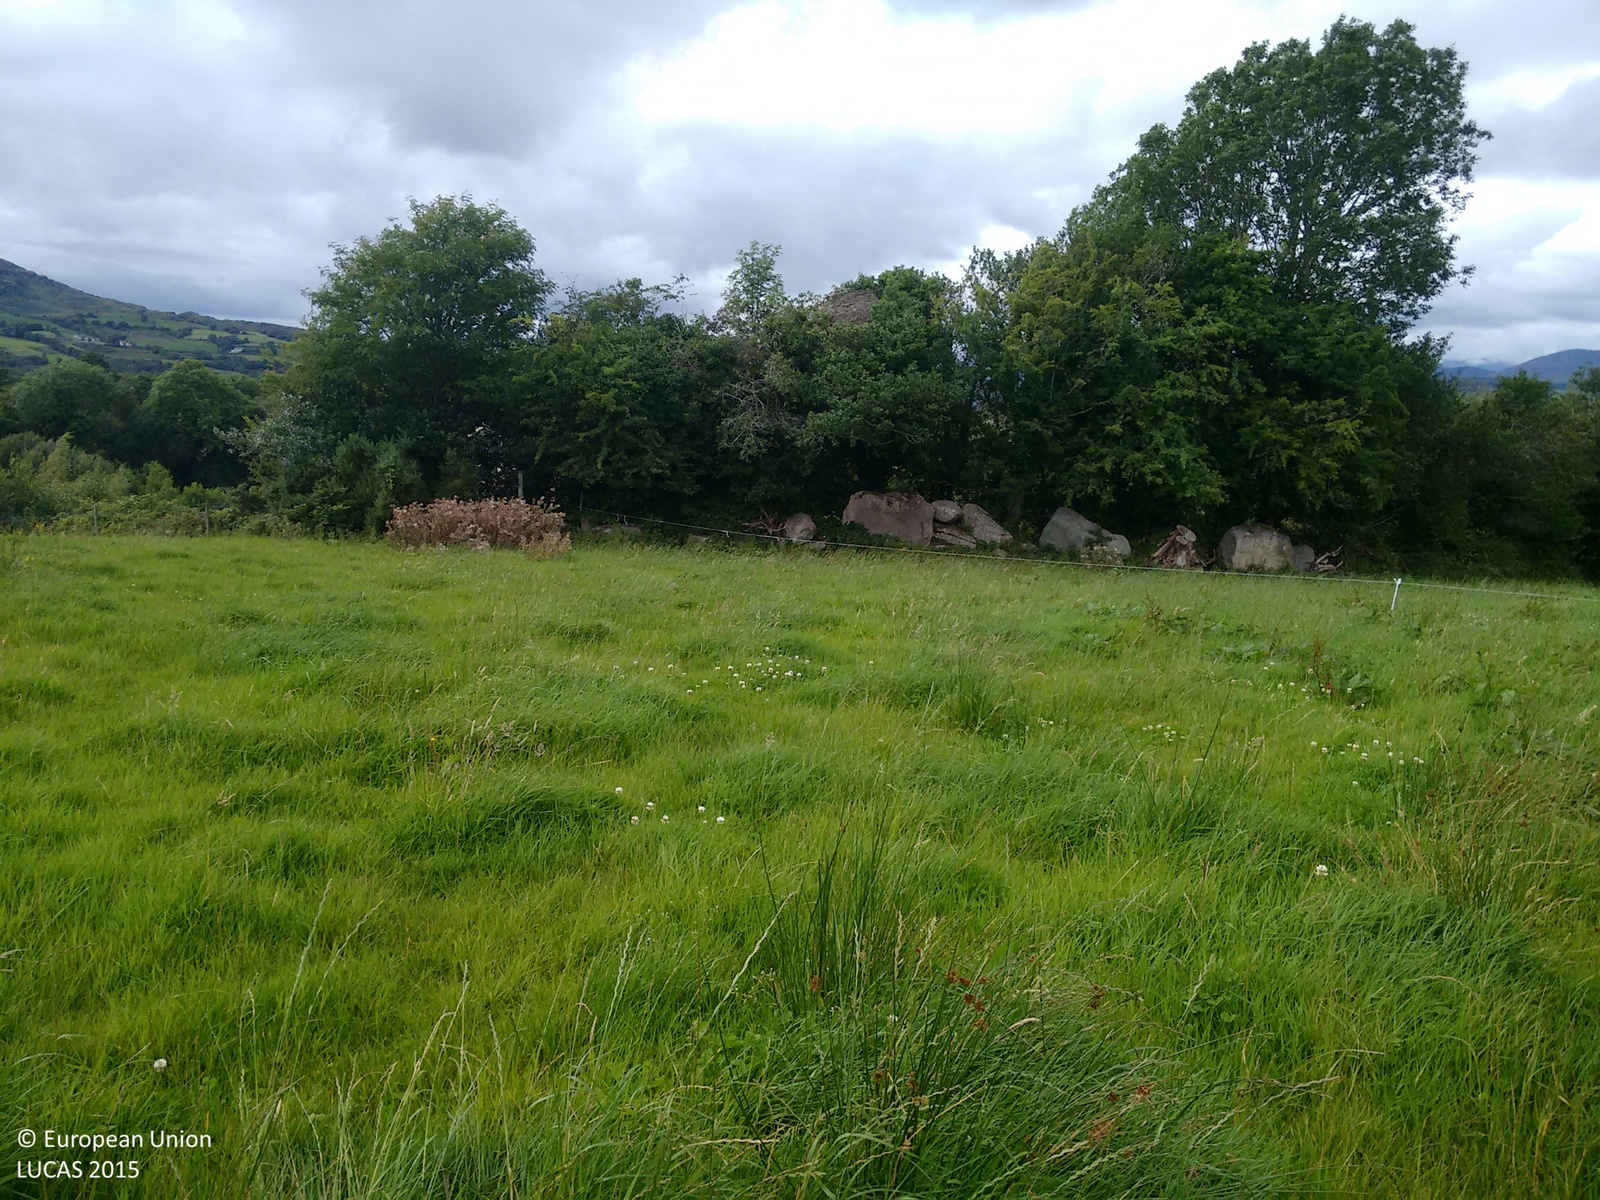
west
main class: Grassland
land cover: Grassland without tree/shrub cover
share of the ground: > 75 %
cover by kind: herbaceous plants 100 %
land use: Agriculture (excluding fallow land and kitchen gardens)
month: August
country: IE
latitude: 51.8612
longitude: -9.5325
